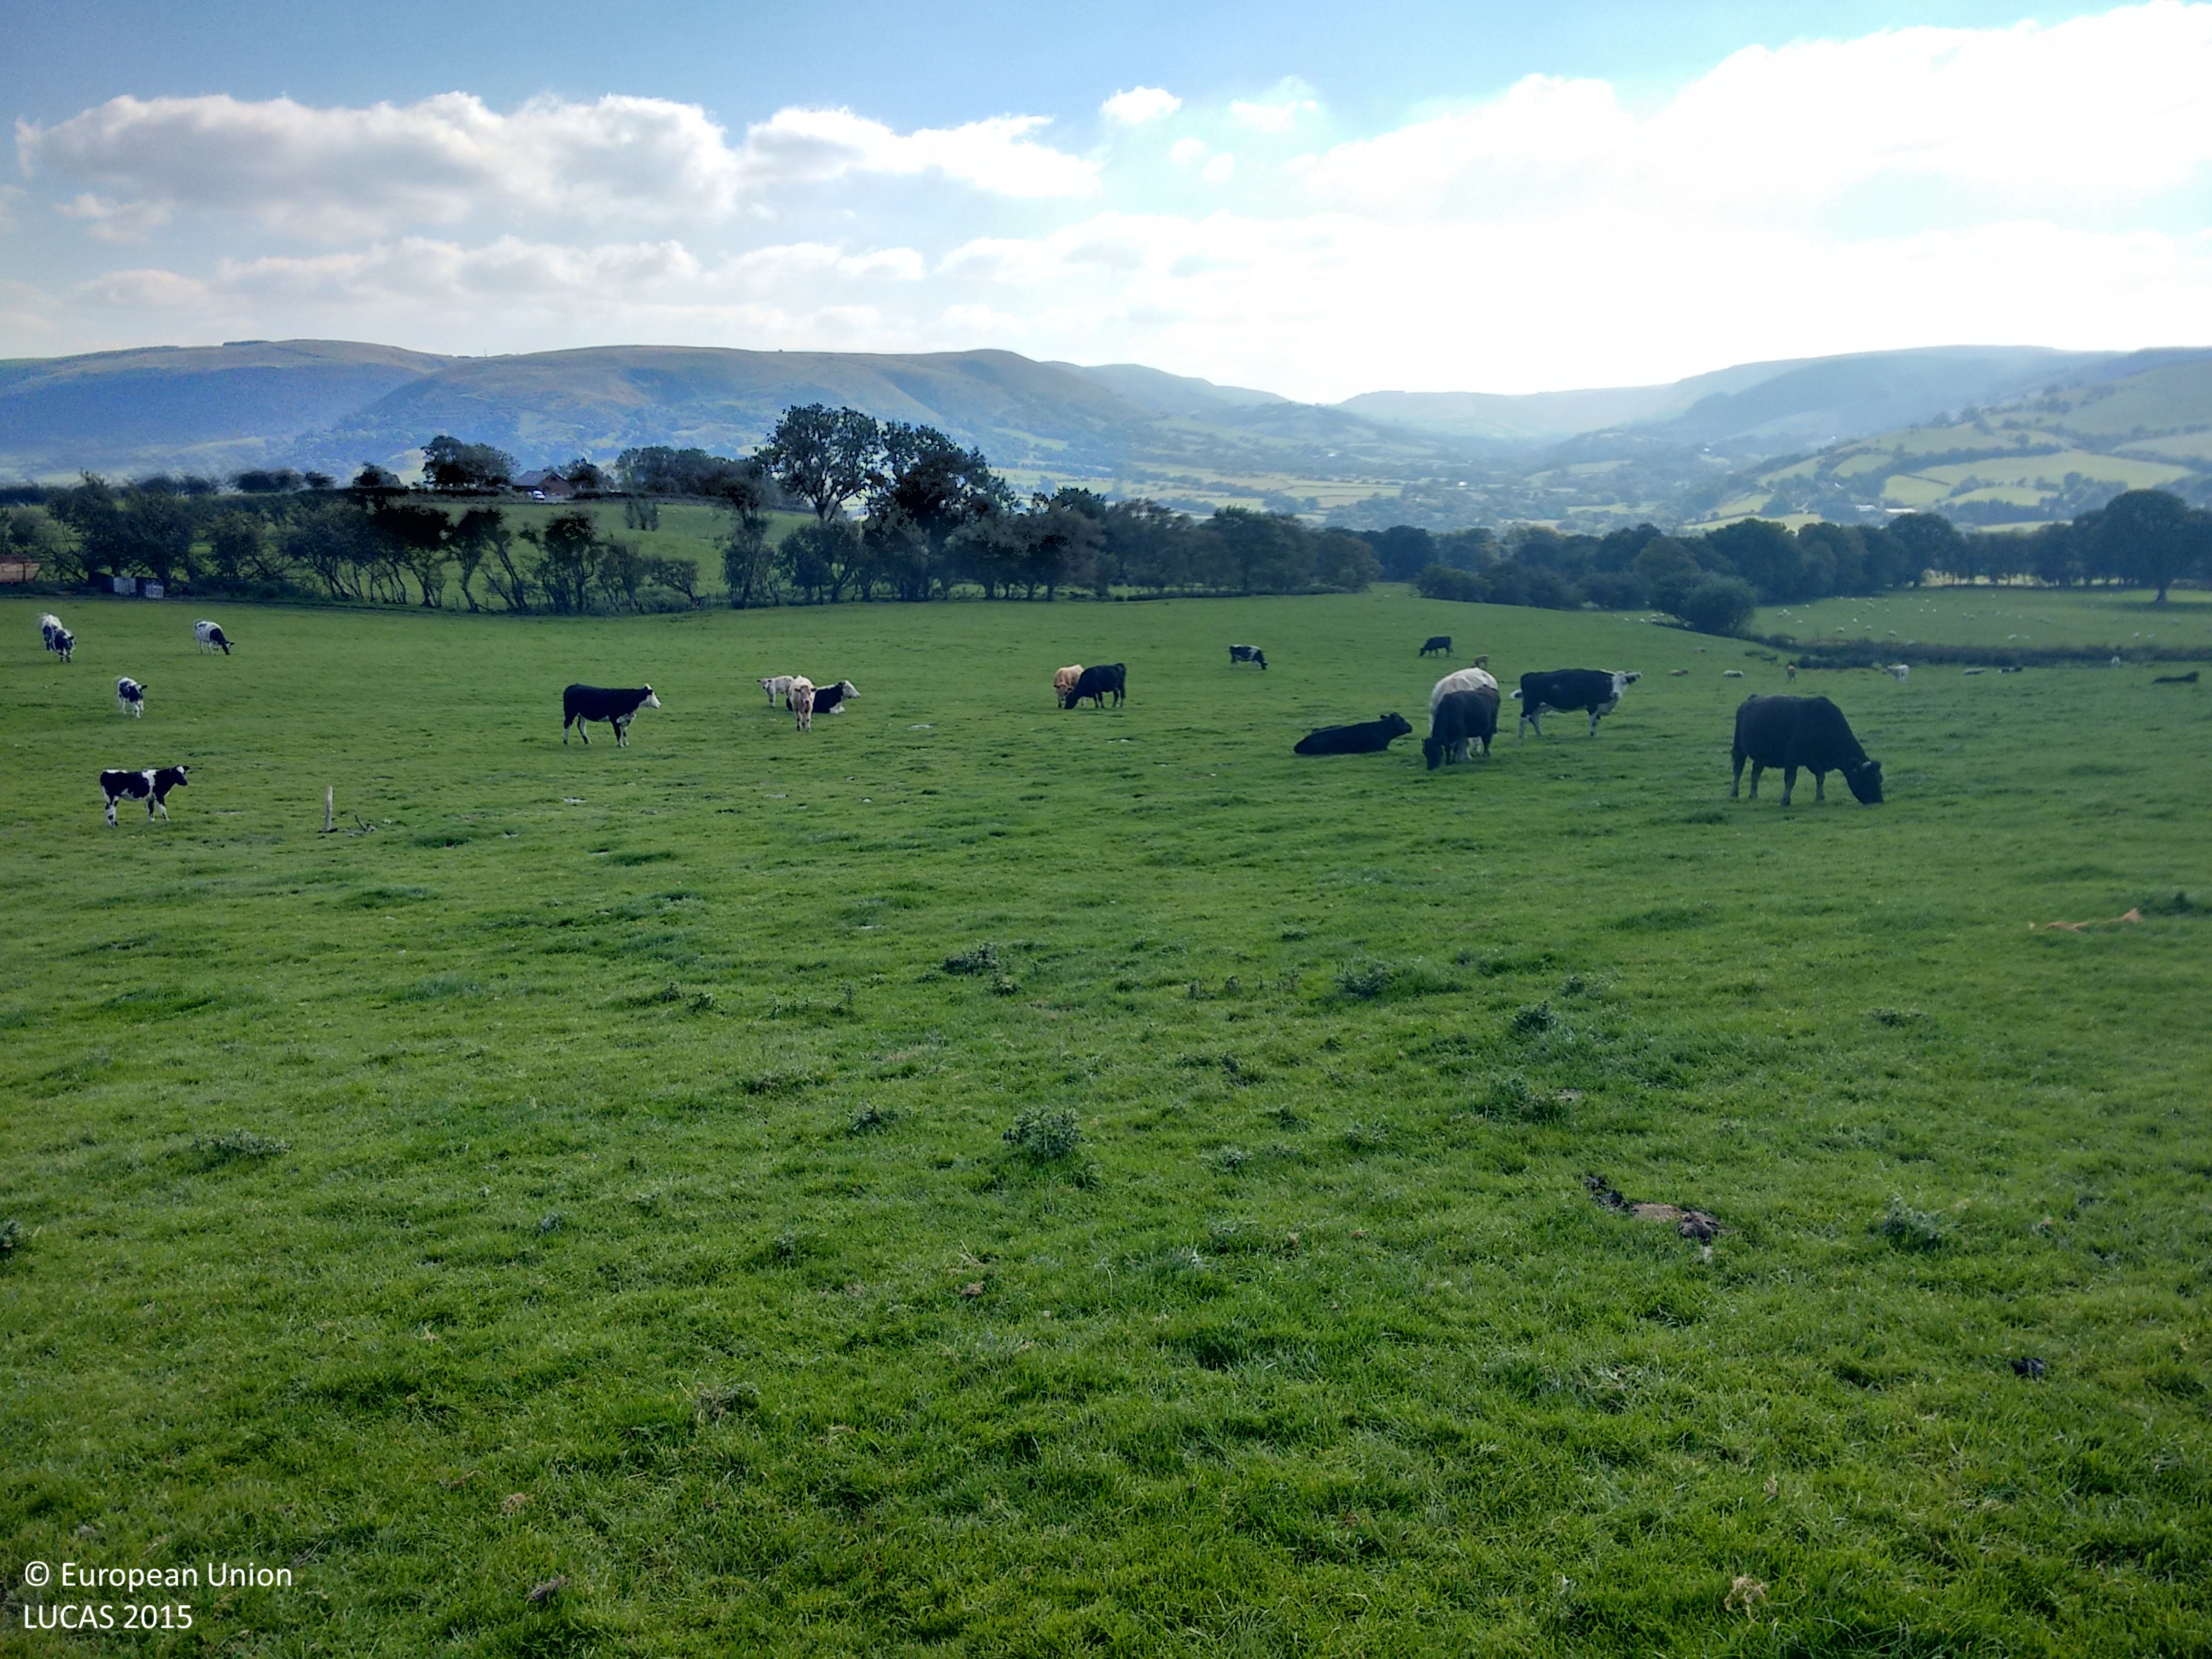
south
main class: Grassland
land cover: Grassland without tree/shrub cover
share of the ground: > 75 %
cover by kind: herbaceous plants 100 %
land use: Agriculture (excluding fallow land and kitchen gardens)
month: September
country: GB
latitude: 52.6260
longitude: -3.6339
